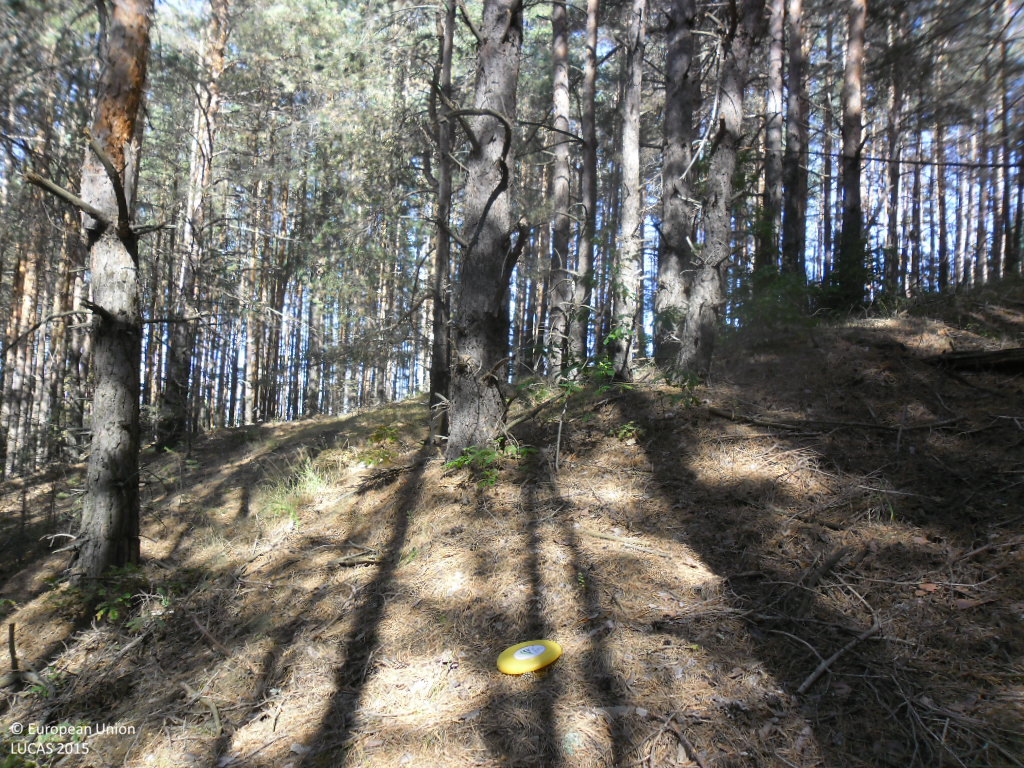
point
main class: Woodland
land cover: Pine dominated coniferous woodland
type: hemiboreal forest and nemoral coniferous forest and mixed broadleaved-coniferous forest
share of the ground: > 75 %
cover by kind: coniferous forest trees 95 %, unconsolidated bare surface 5 %
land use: Forestry
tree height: > 5 m
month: October
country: BG
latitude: 42.1140
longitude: 22.9278
